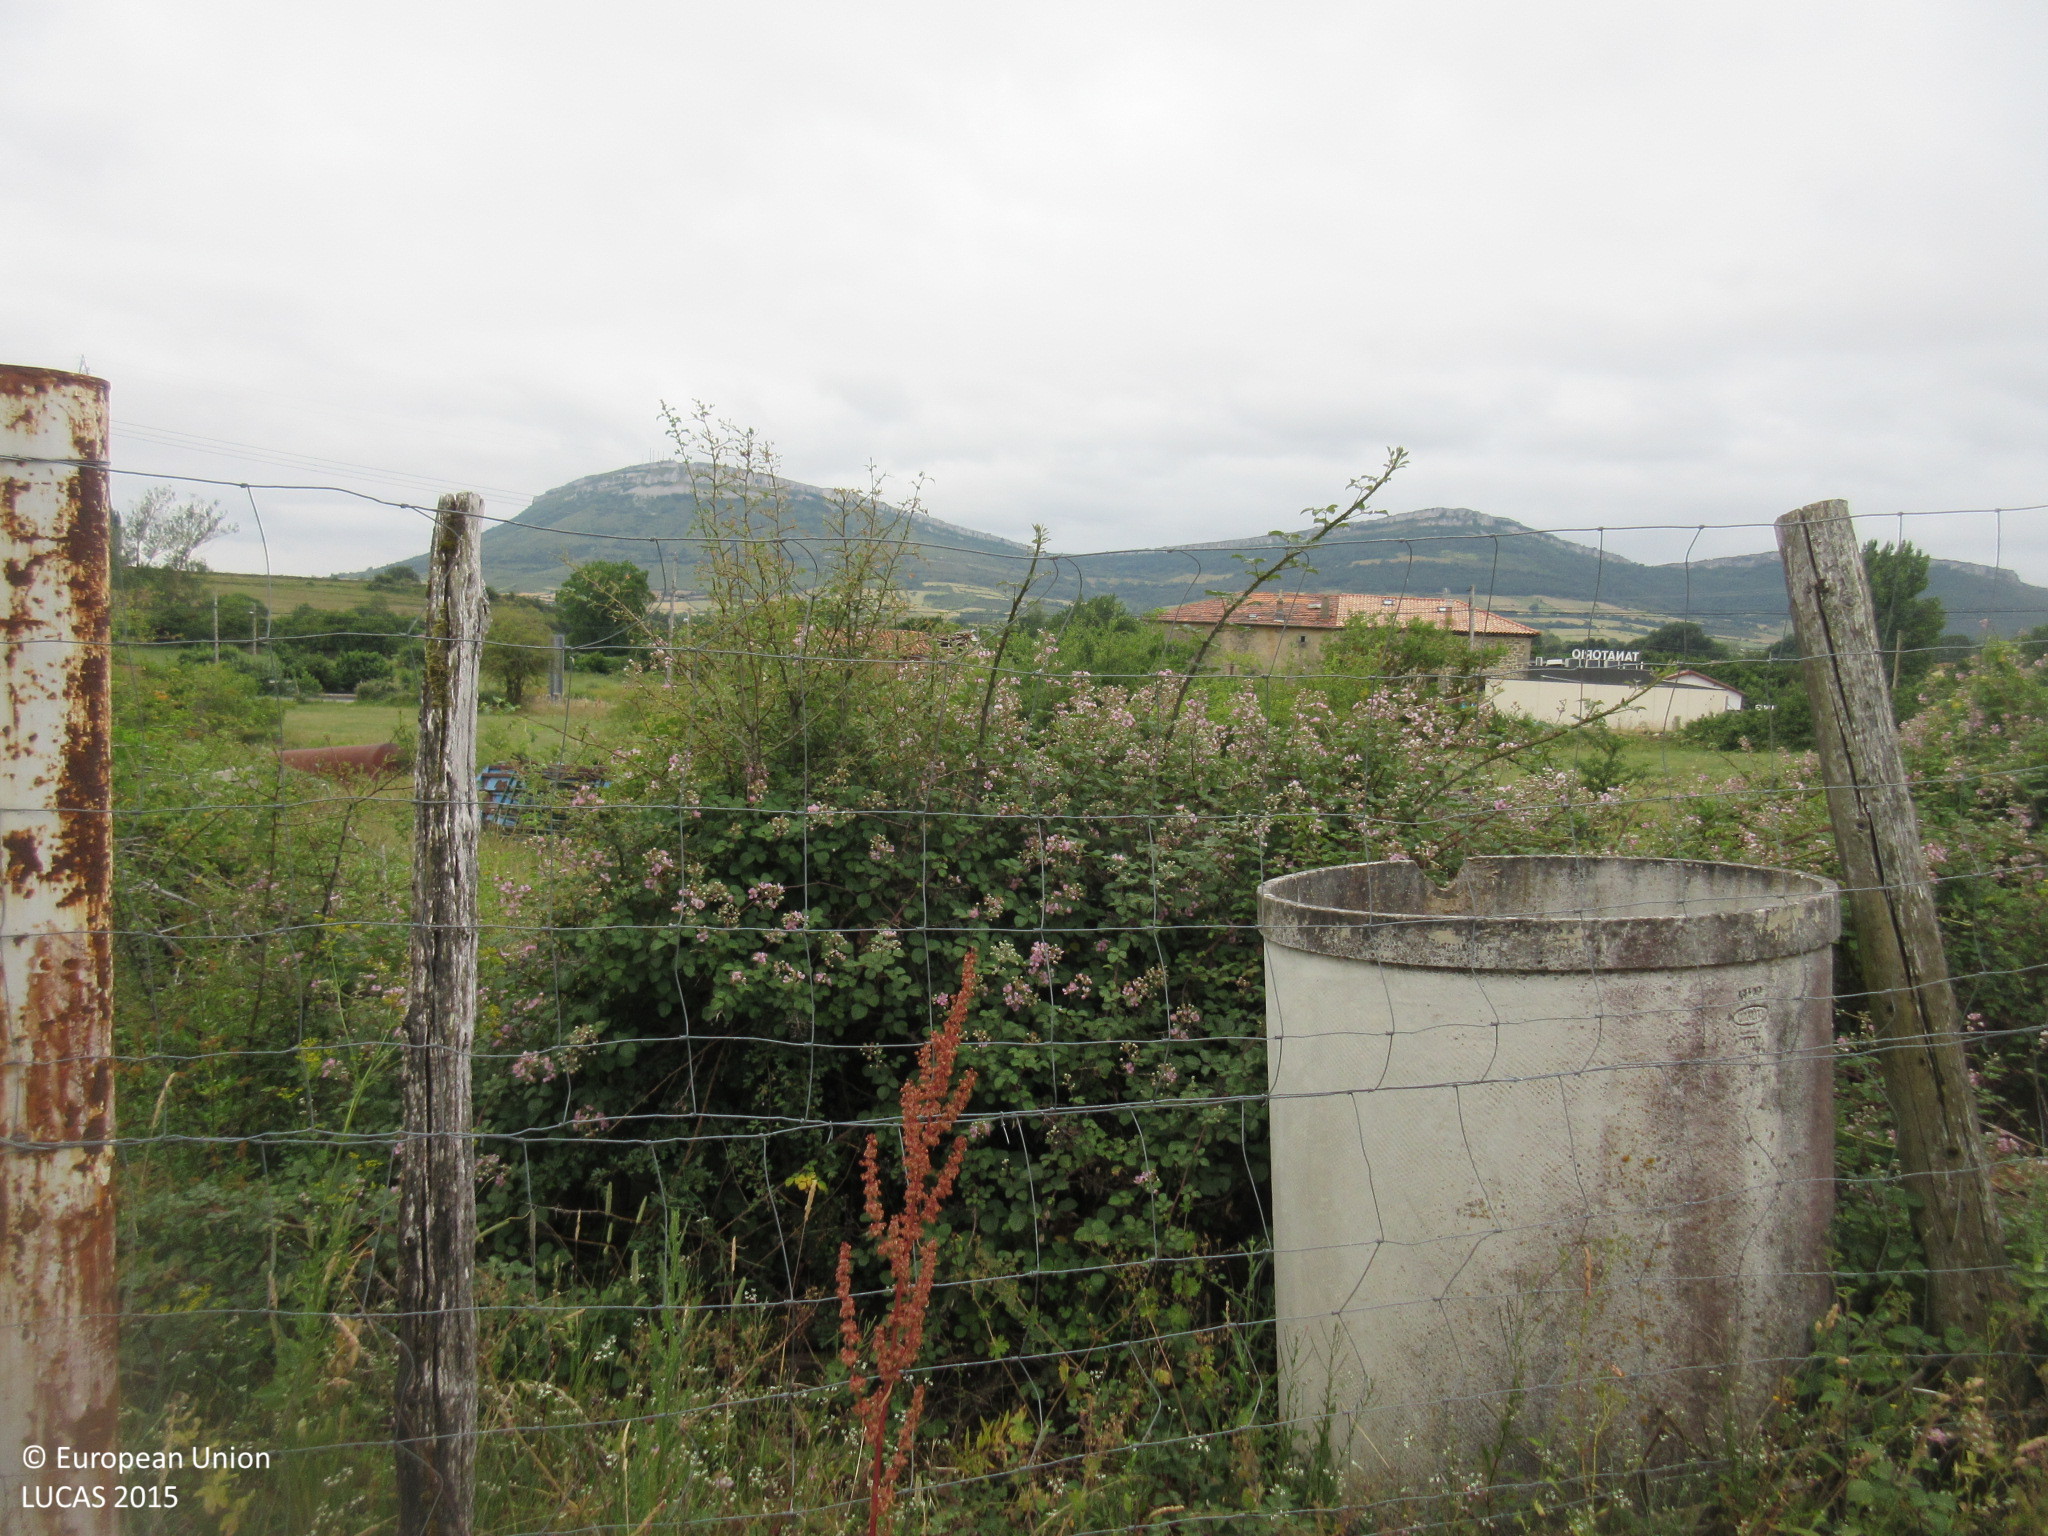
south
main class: Shrubland
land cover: Shrubland with sparse tree cover
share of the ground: > 75 %
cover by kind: shrubs 95 %, broadleaved forest trees 5 %
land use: Semi-natural and natural areas not in use
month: July
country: ES
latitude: 43.0749
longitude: -3.5387
